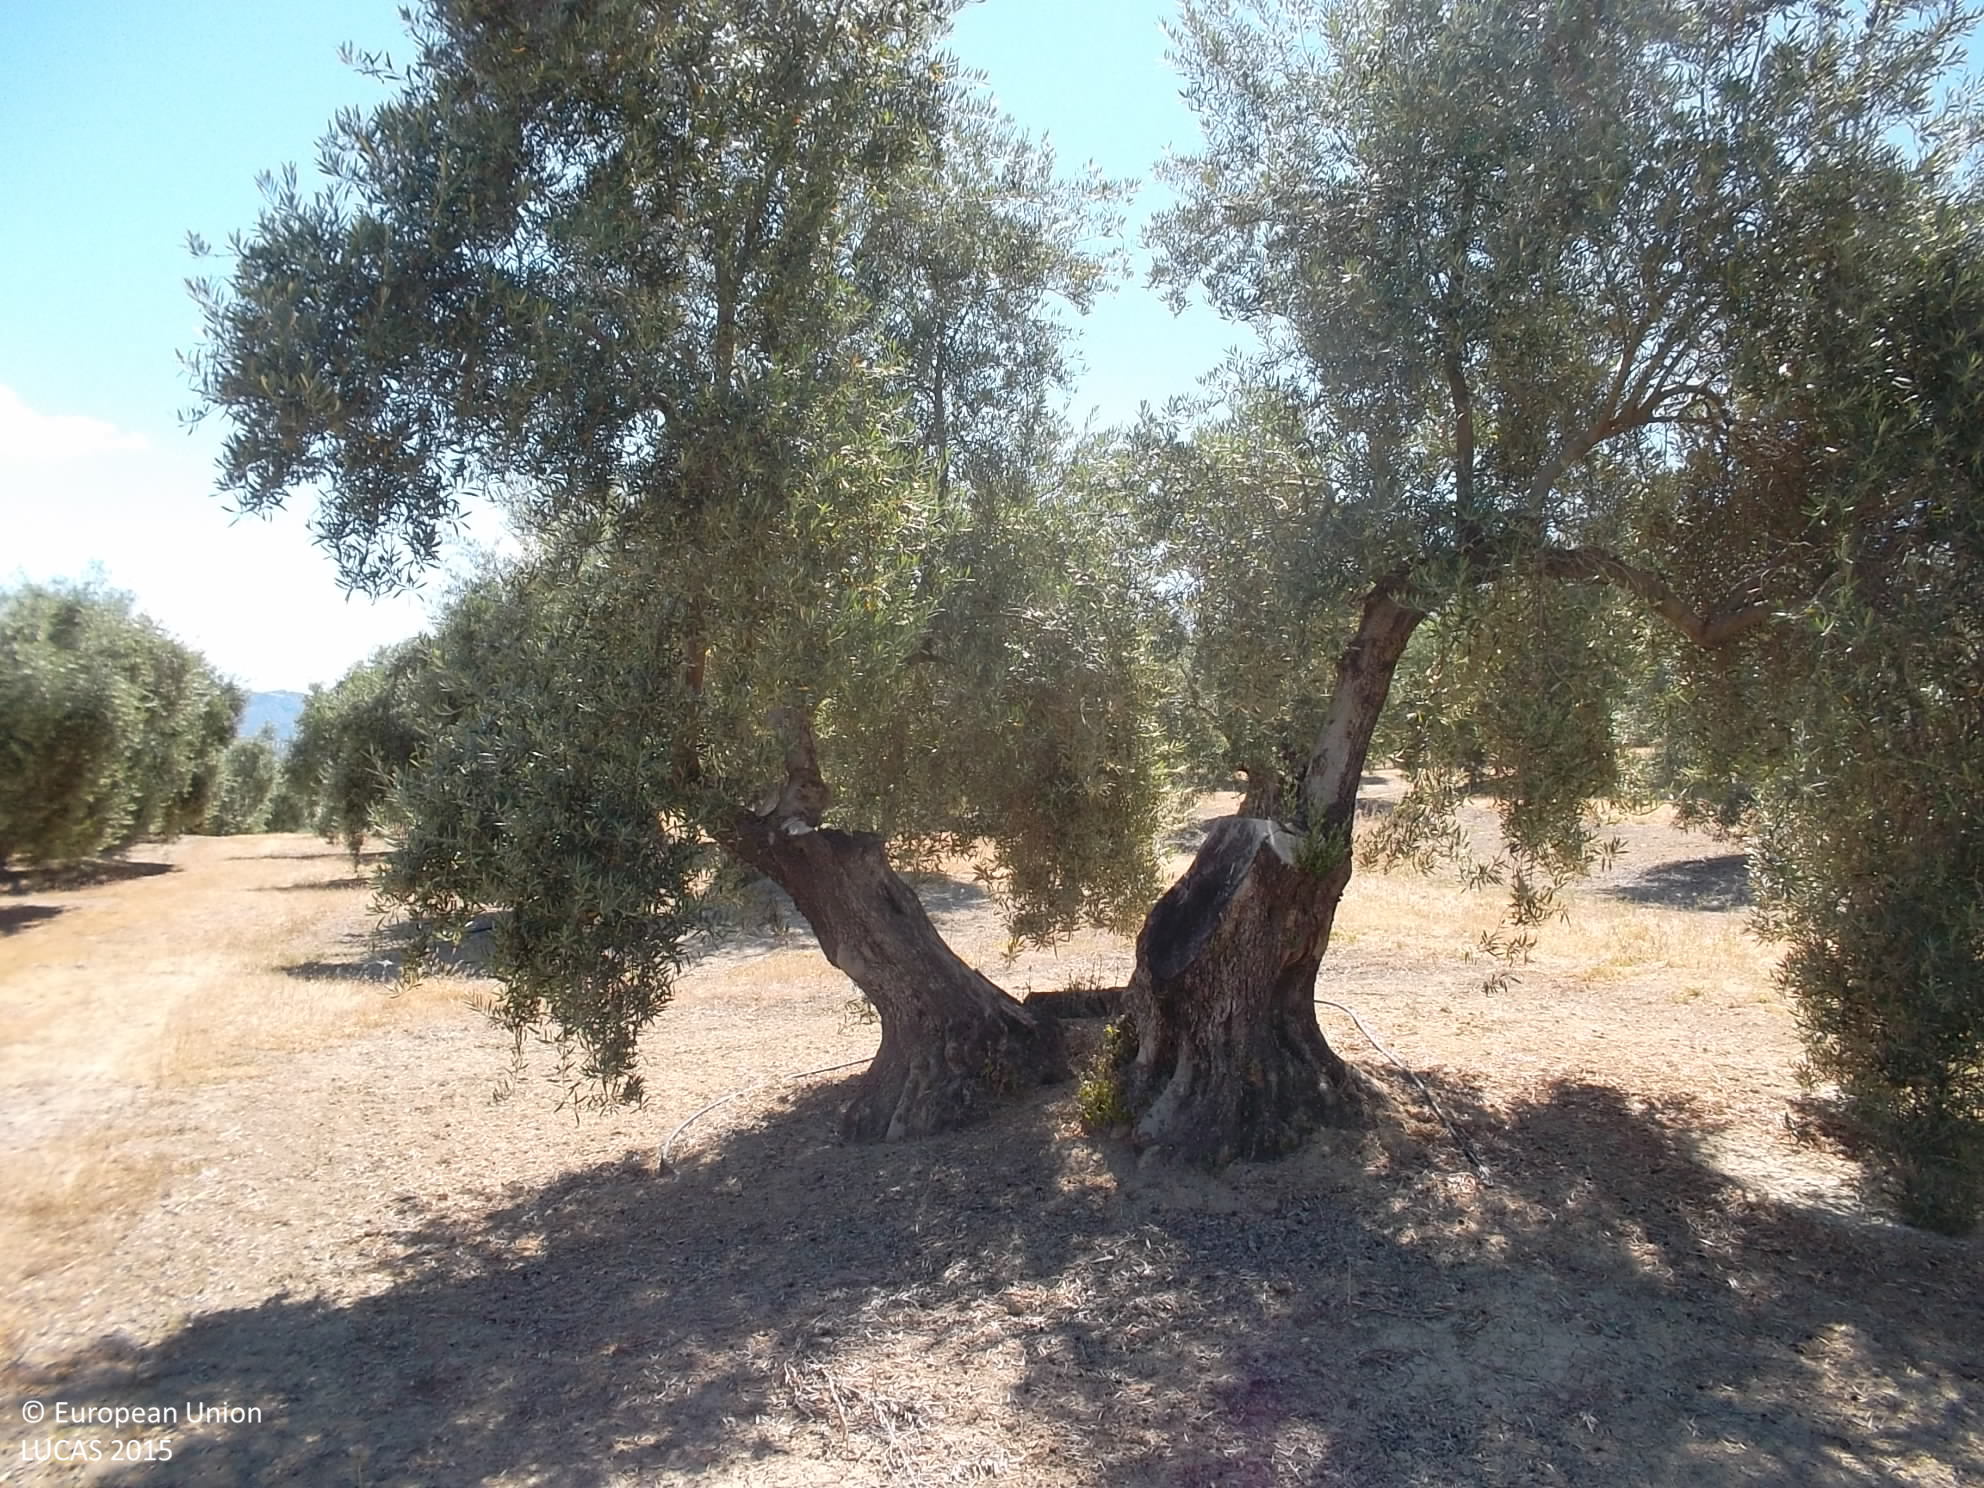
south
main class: Cropland
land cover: Olive groves
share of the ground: 50 - 75 %
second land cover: Other bare soil
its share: > 75 %
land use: Agriculture (excluding fallow land and kitchen gardens)
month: June
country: ES
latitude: 37.9447
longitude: -3.0482
